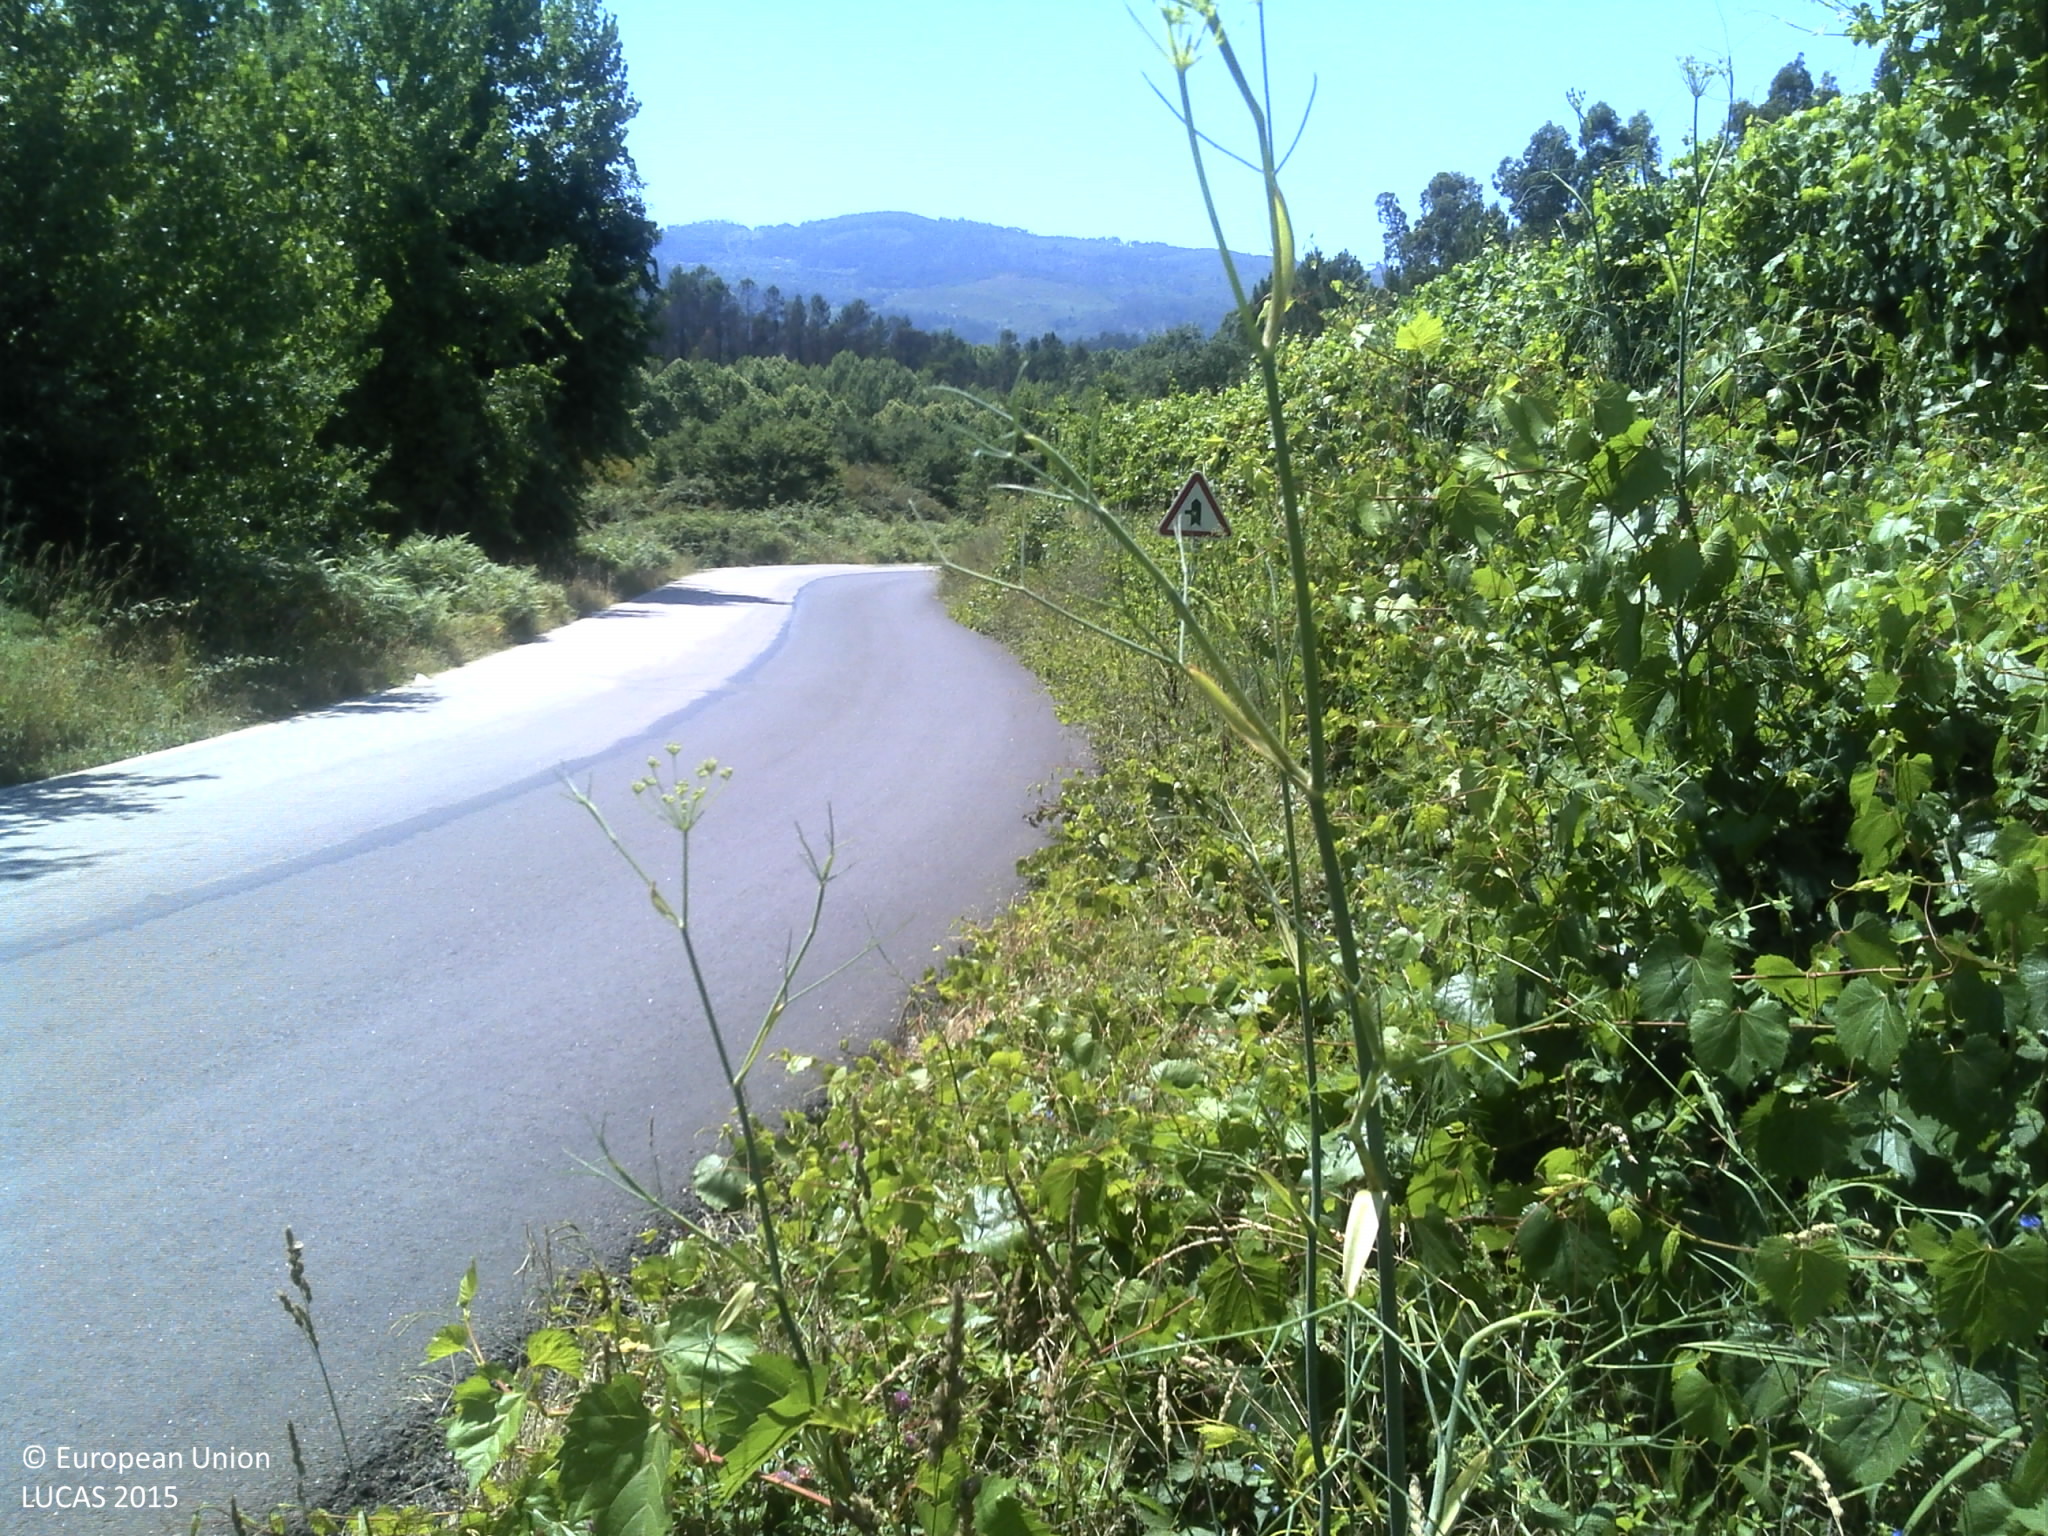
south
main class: Shrubland
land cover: Shrubland without tree cover
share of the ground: > 75 %
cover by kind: shrubs 75 %, consolidated bare surface 15 %, herbaceous plants 10 %
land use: Road transport
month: June
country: PT
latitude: 41.4174
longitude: -7.9776
